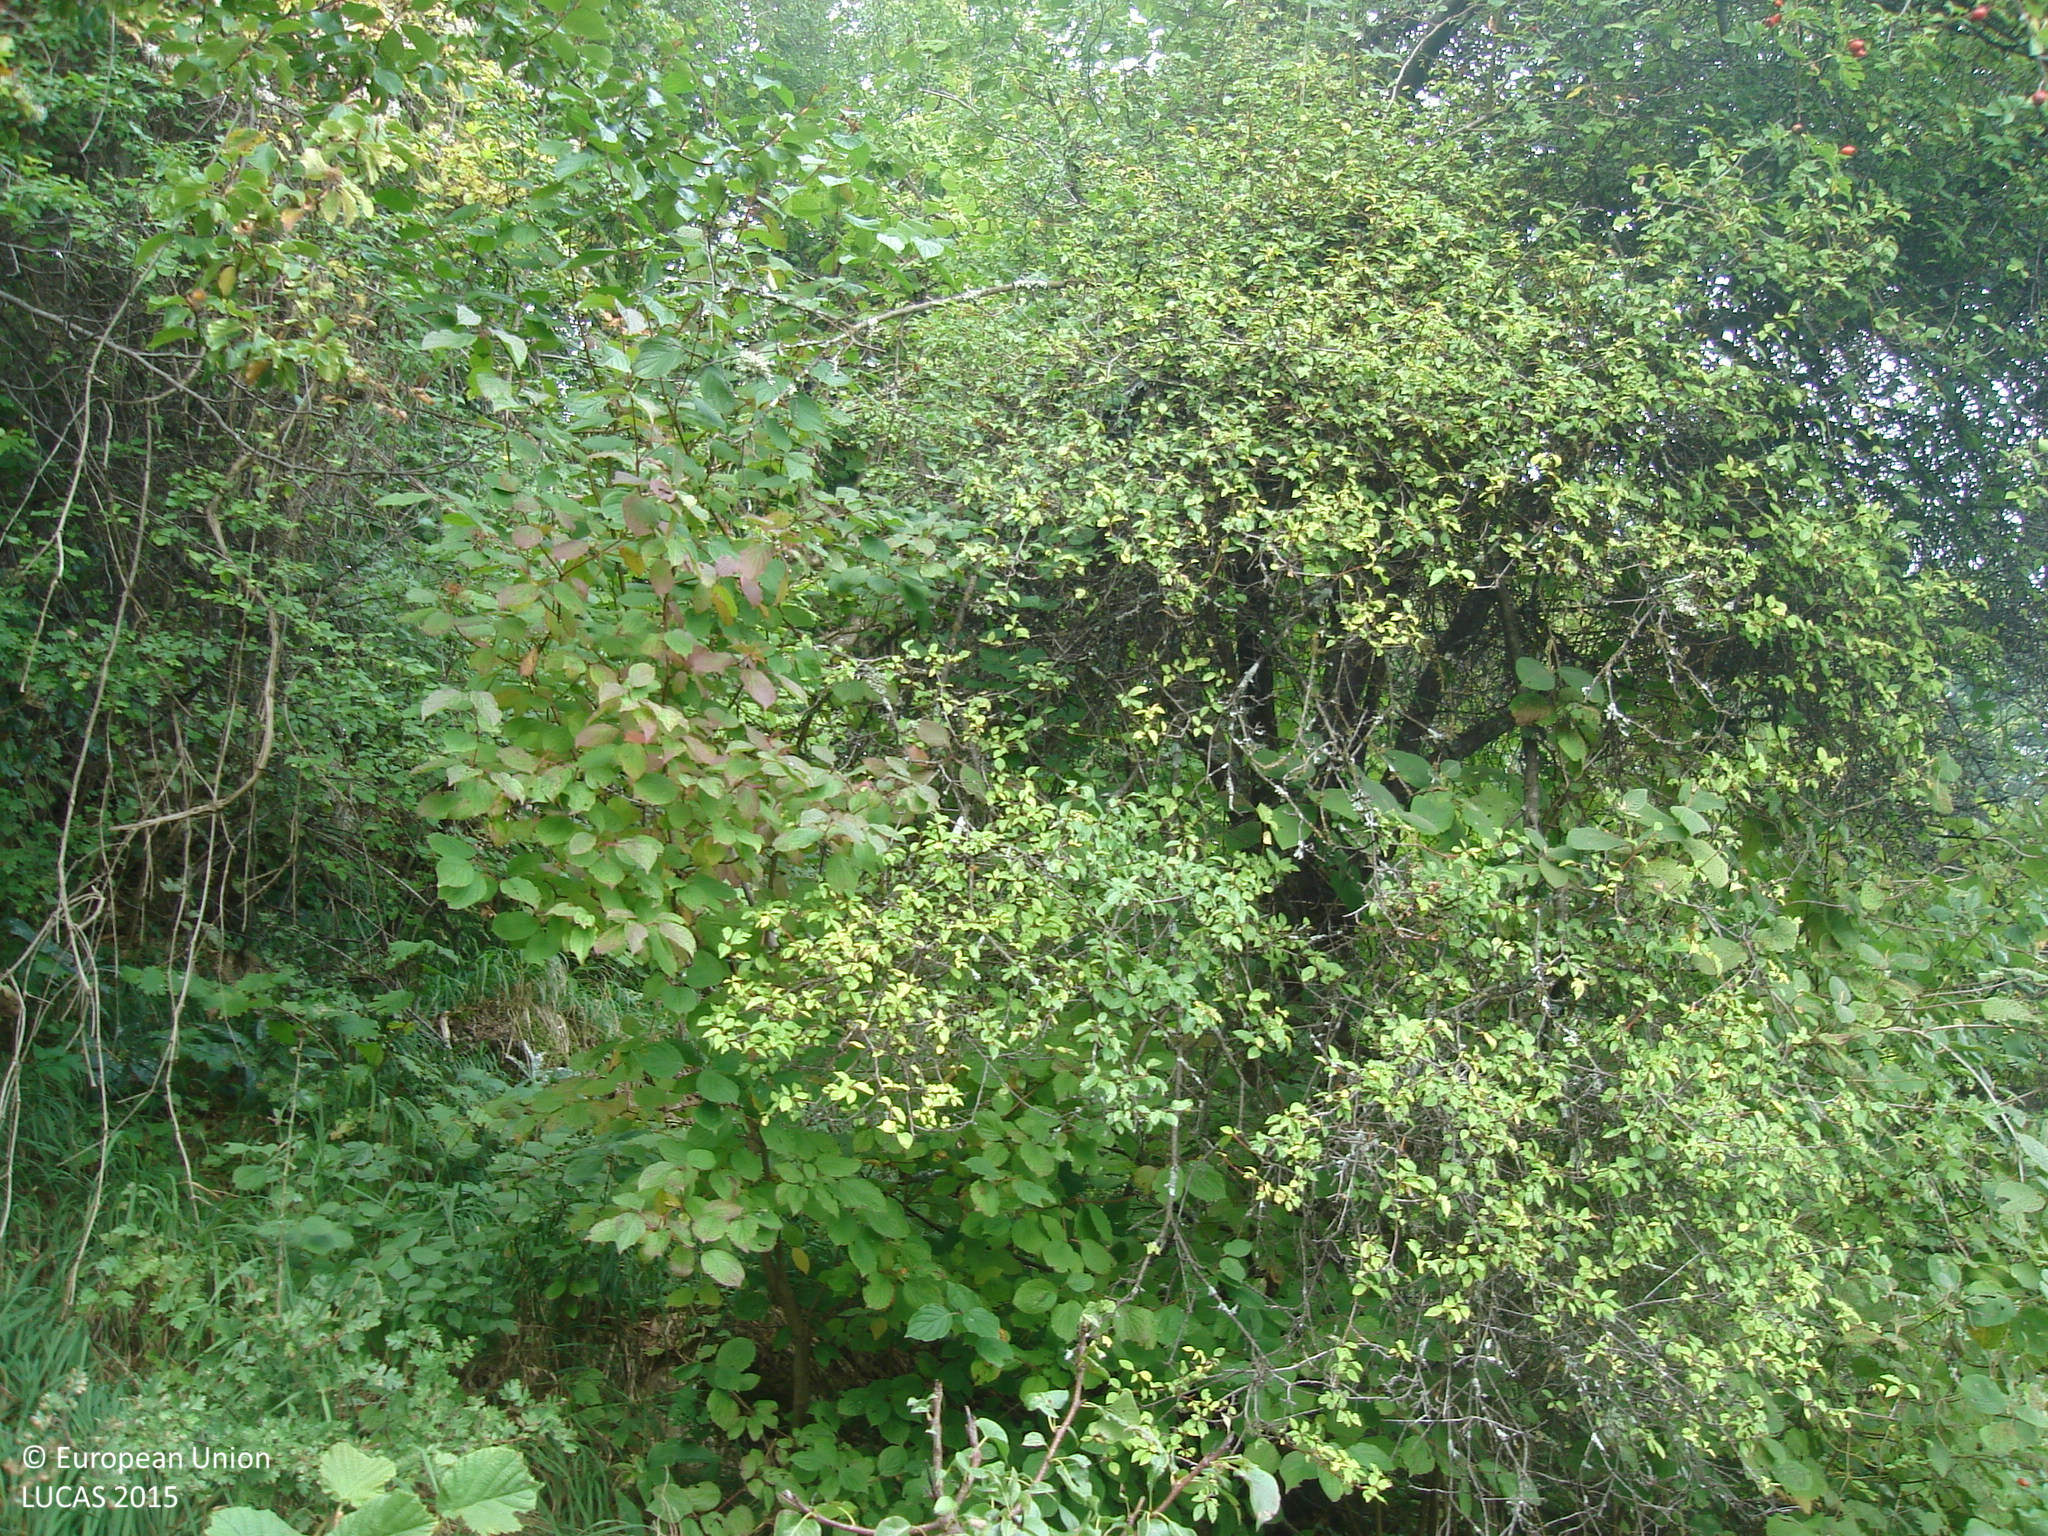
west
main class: Woodland
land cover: Broadleaved woodland
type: mesophytic deciduous forest
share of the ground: 50 - 75 %
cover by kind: broadleaved forest trees 60 %, shrubs 20 %, herbaceous plants 20 %
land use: Semi-natural and natural areas not in use
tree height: > 5 m
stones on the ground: < 10 %
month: October
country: BG
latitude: 43.0506
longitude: 23.3087
